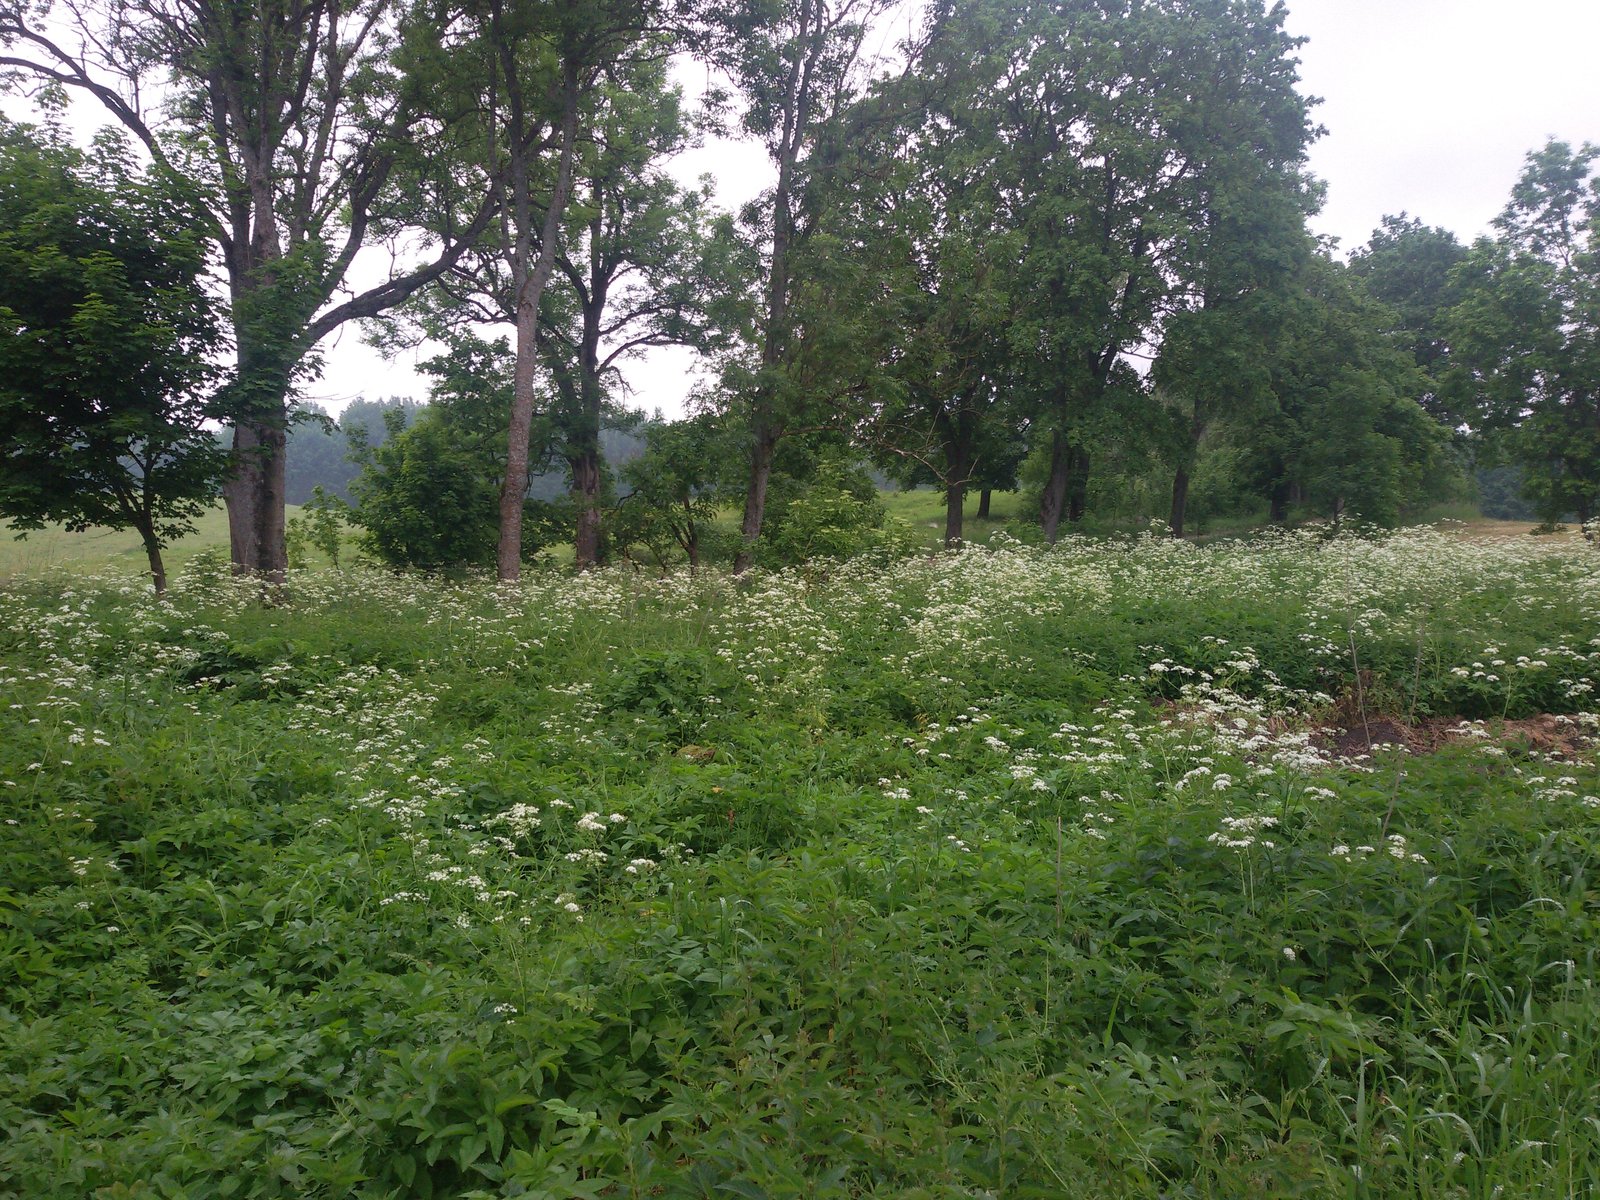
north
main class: Woodland
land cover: Broadleaved woodland
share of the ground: 10 - 25 %
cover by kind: herbaceous plants 85 %, broadleaved forest trees 15 %
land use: Semi-natural and natural areas not in use
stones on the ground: 25 - 50 %
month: June
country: PL
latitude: 54.1731
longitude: 22.3013
